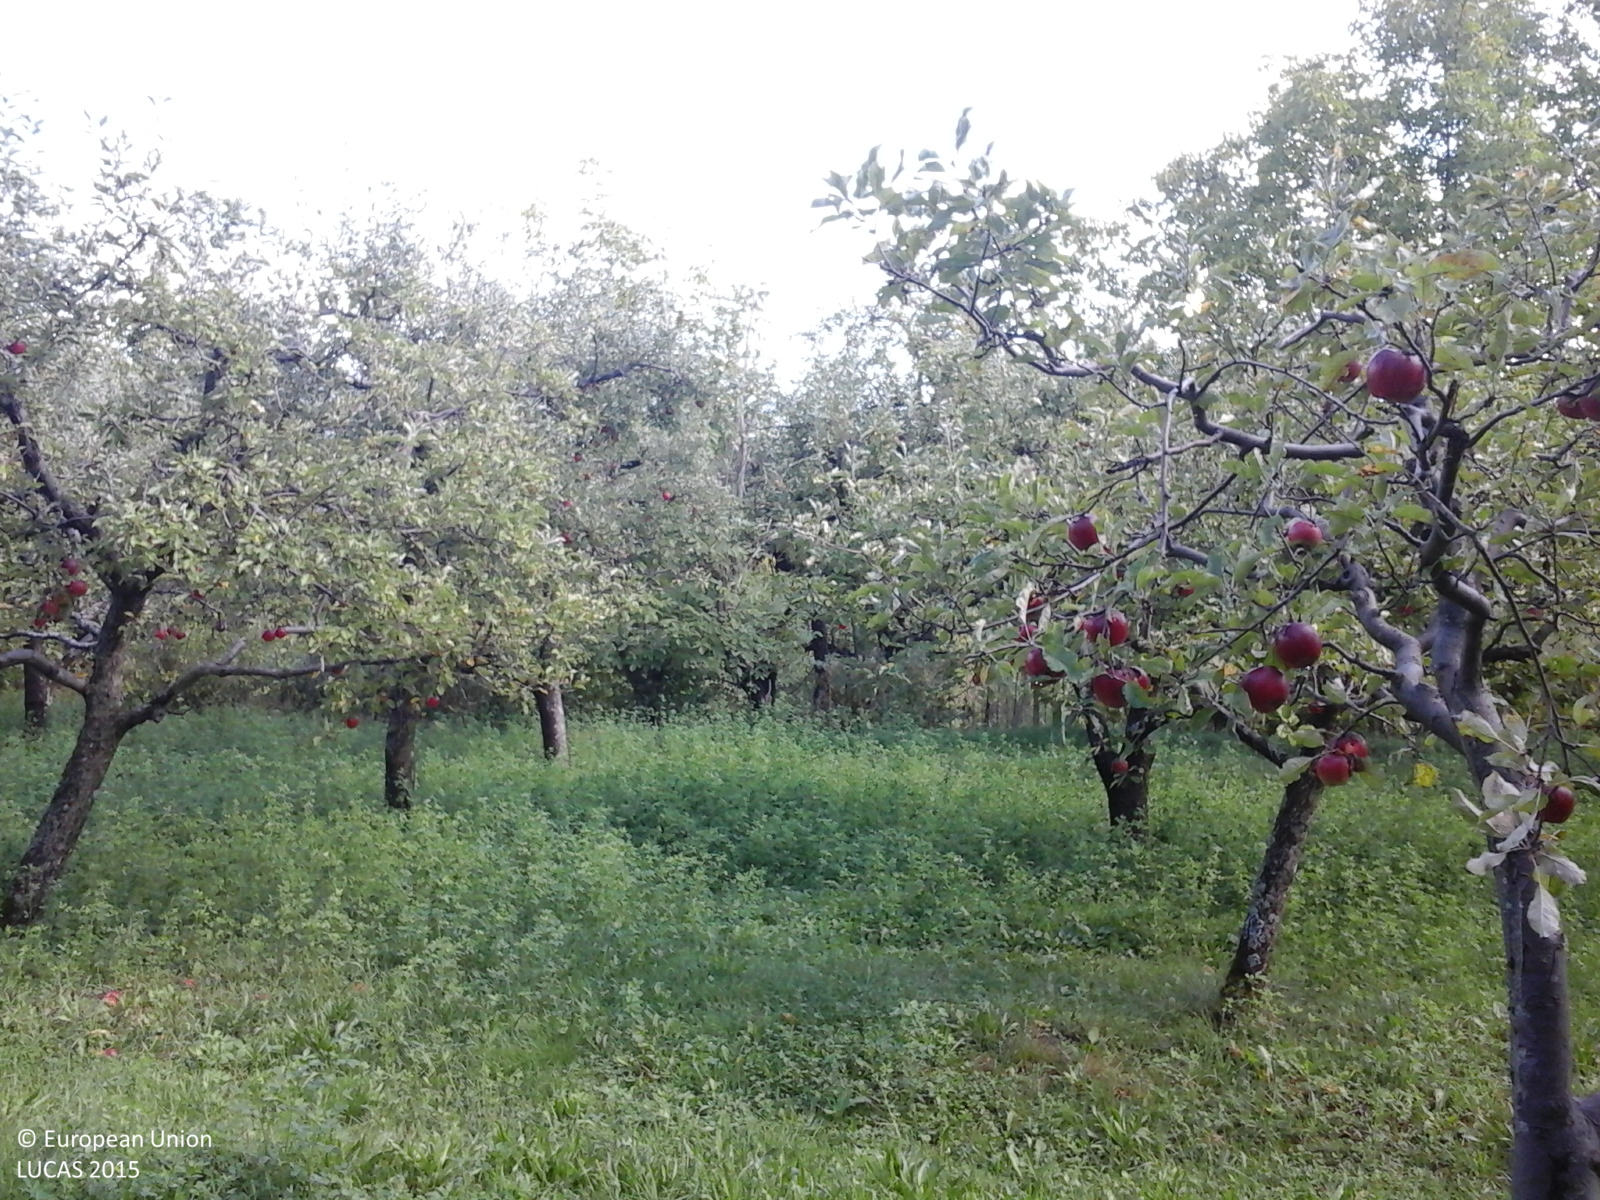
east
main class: Cropland
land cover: Apple fruit
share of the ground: 25 - 50 %
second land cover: Grassland without tree/shrub cover
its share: > 75 %
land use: Agriculture (excluding fallow land and kitchen gardens)
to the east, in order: Apple fruit; Grassland without tree/shrub cover; Fences; Grassland with sparse tree/shrub cover; Tracks; Grassland with sparse tree/shrub cover; Spontaneously vegetated surfaces; Tracks; Broadleaved woodland; Other fruit trees and berries; Grassland without tree/shrub cover; Artificial constructions in urban areas
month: September
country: RO
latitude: 45.1888
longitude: 24.5234
